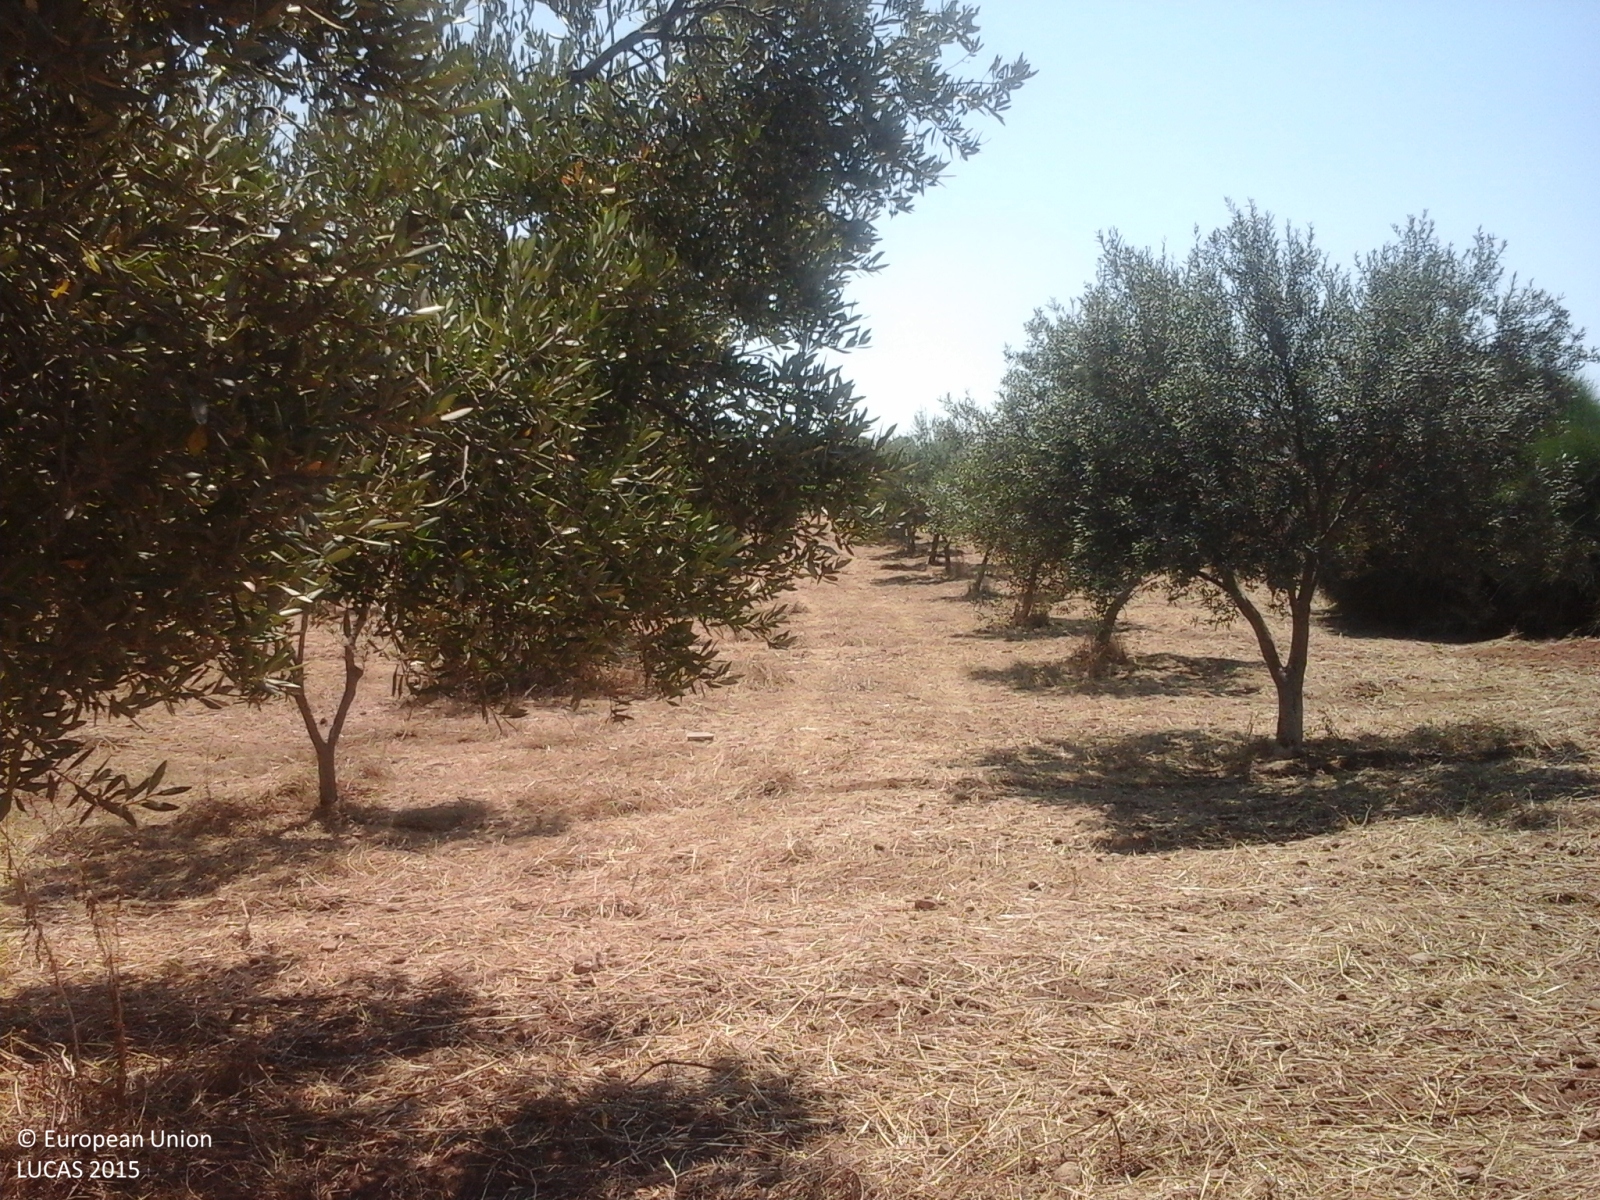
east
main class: Cropland
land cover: Other fruit trees and berries
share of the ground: 25 - 50 %
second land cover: Spontaneously vegetated surfaces
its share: > 75 %
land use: Kitchen garden
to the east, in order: Other fruit trees and berries; Spontaneously vegetated surfaces; Artificial constructions in urban areas; Olive groves; Electric lines; Olive groves; Paved roads, cycling and walking lanes
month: July
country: IT
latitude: 37.2807
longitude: 13.5699
